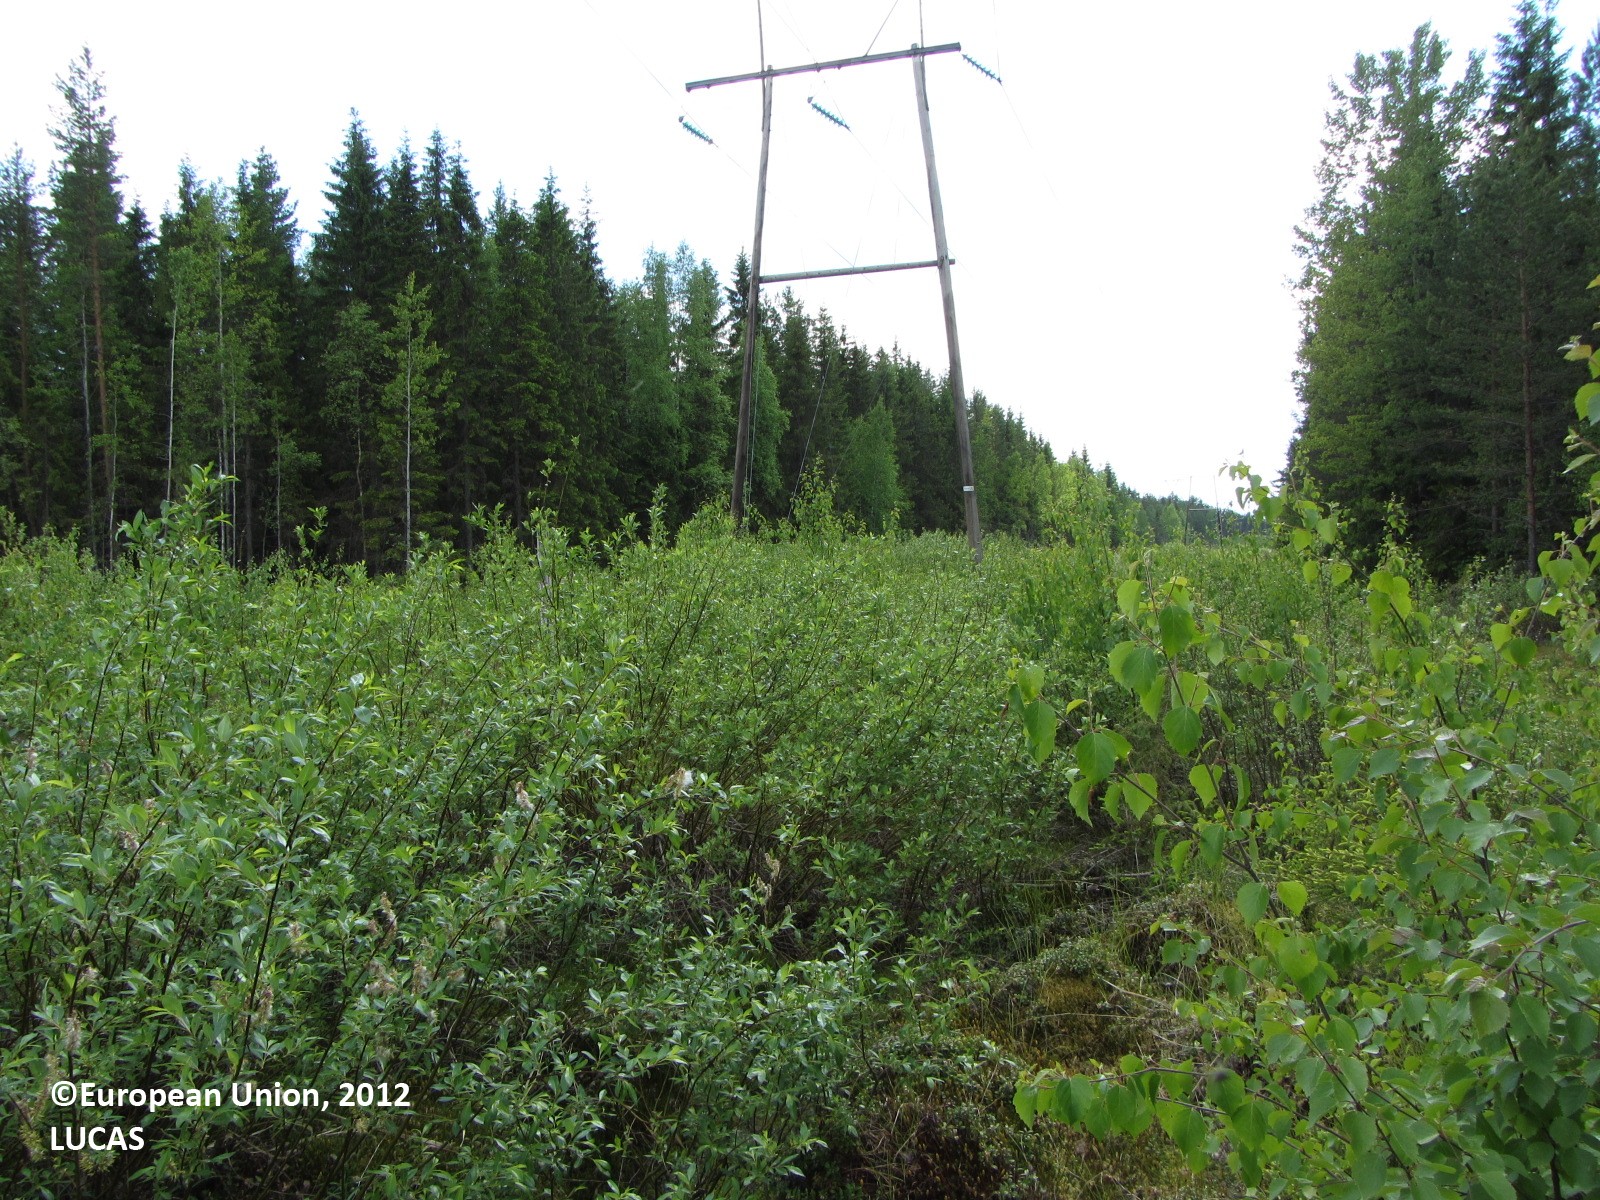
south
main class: Woodland
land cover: Broadleaved woodland
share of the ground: 25 - 50 %
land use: Energy production
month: June
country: FI
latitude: 62.2768
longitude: 25.1942
